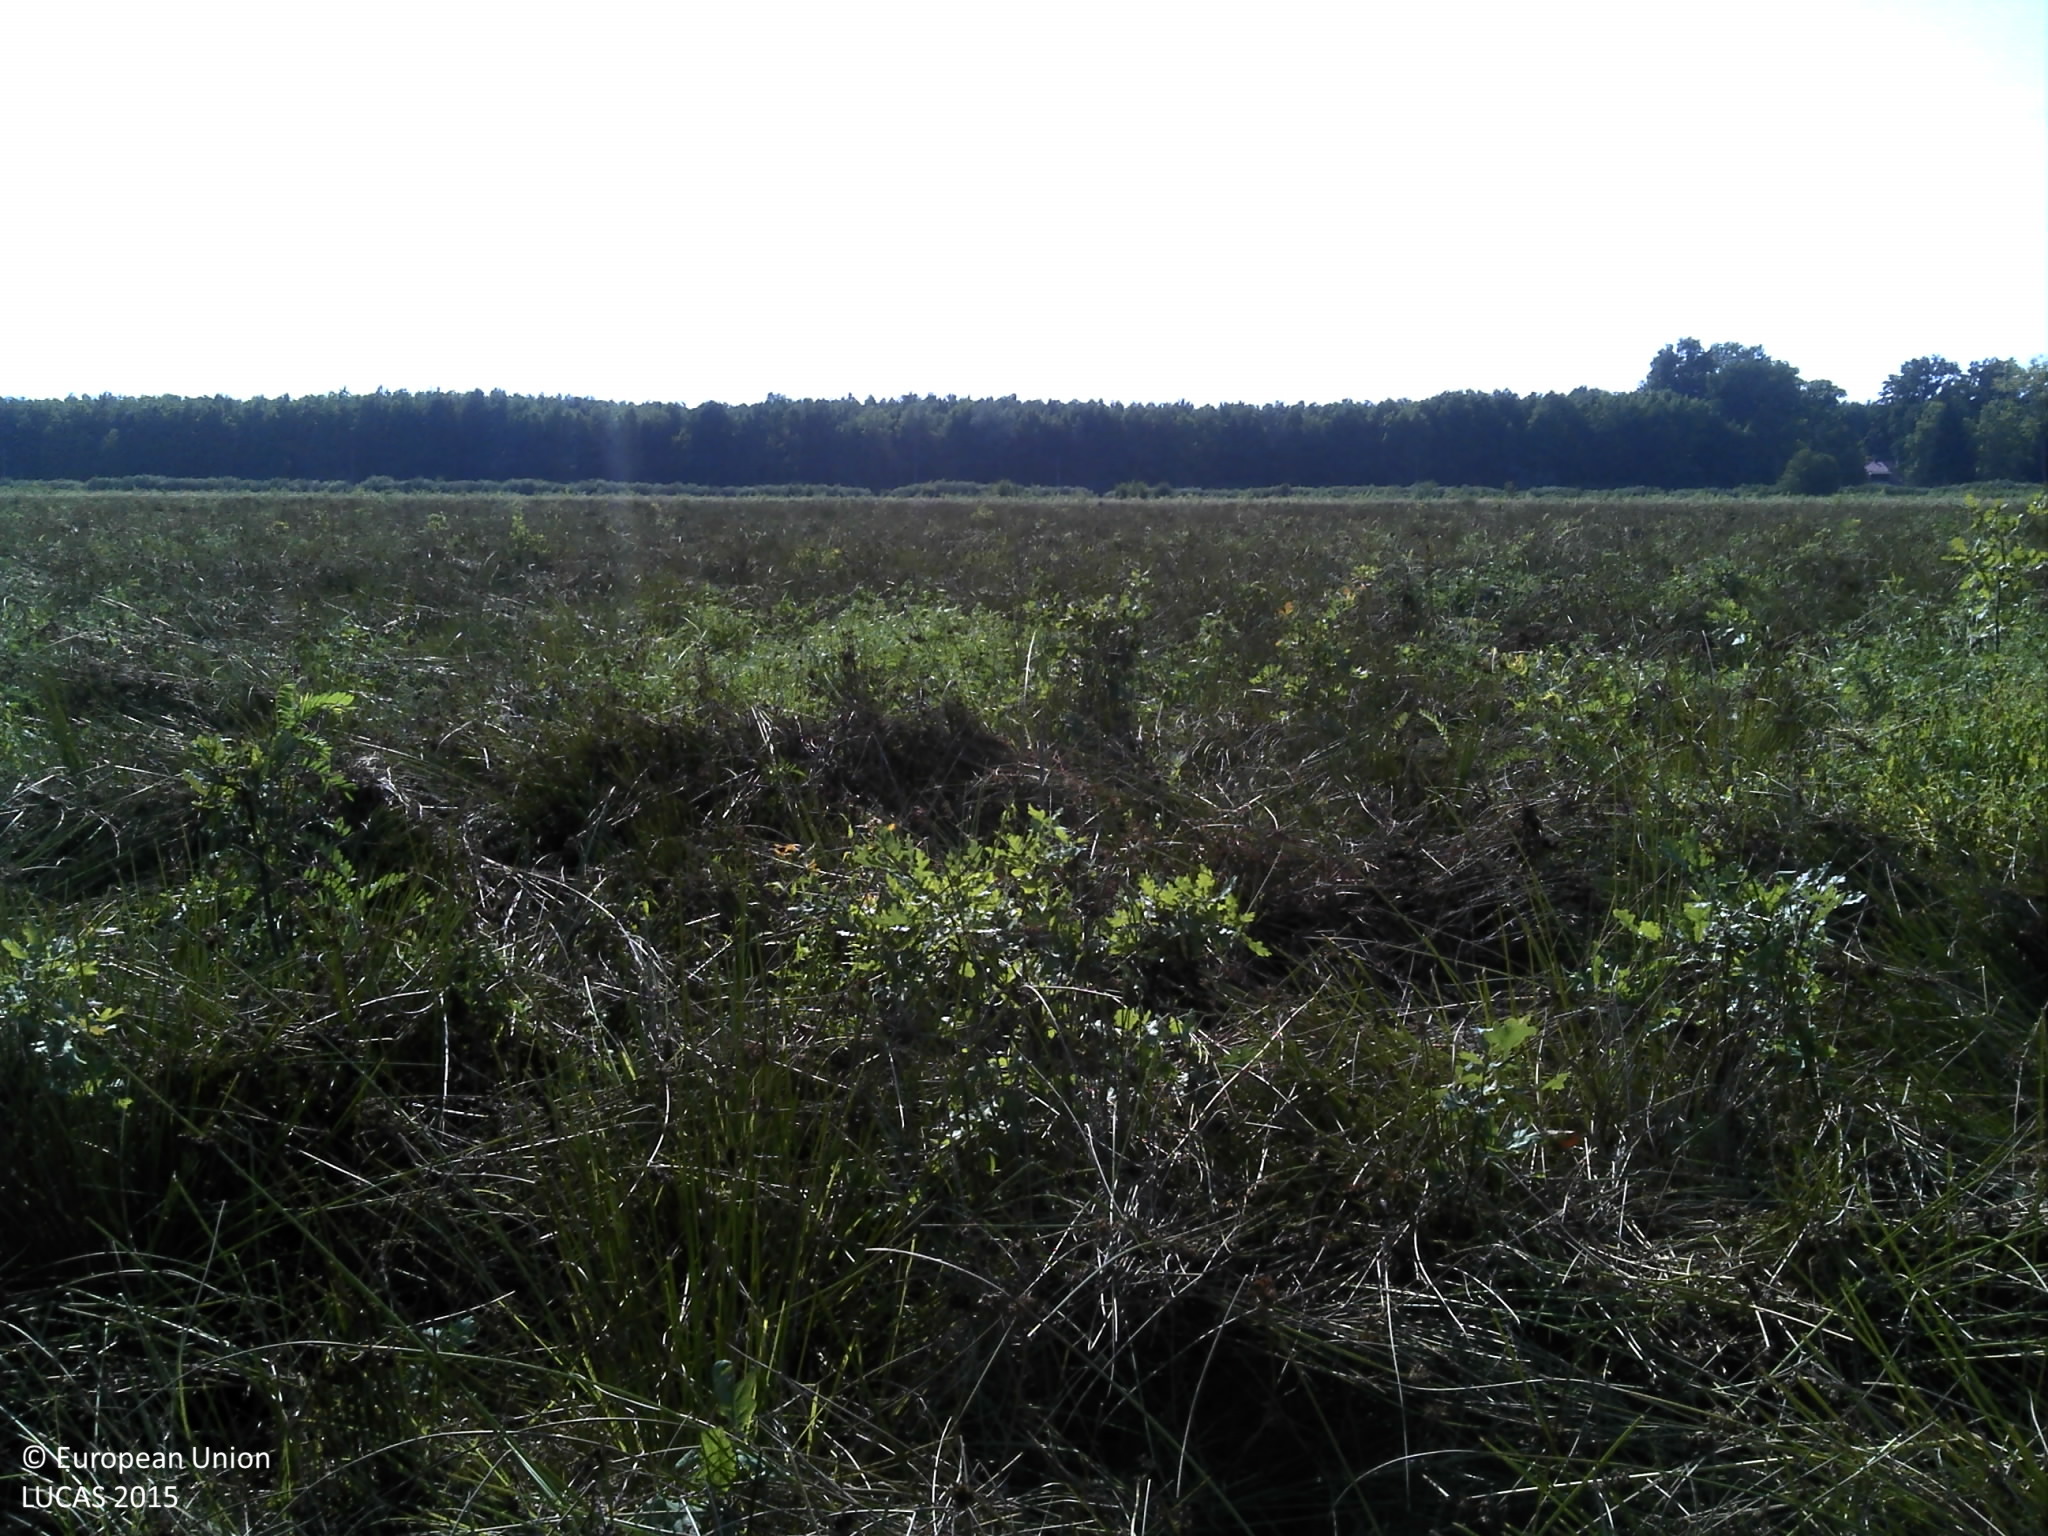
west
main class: Grassland
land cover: Grassland without tree/shrub cover
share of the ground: > 75 %
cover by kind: herbaceous plants 100 %
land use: Forestry
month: August
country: HR
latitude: 45.3099
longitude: 16.6944
